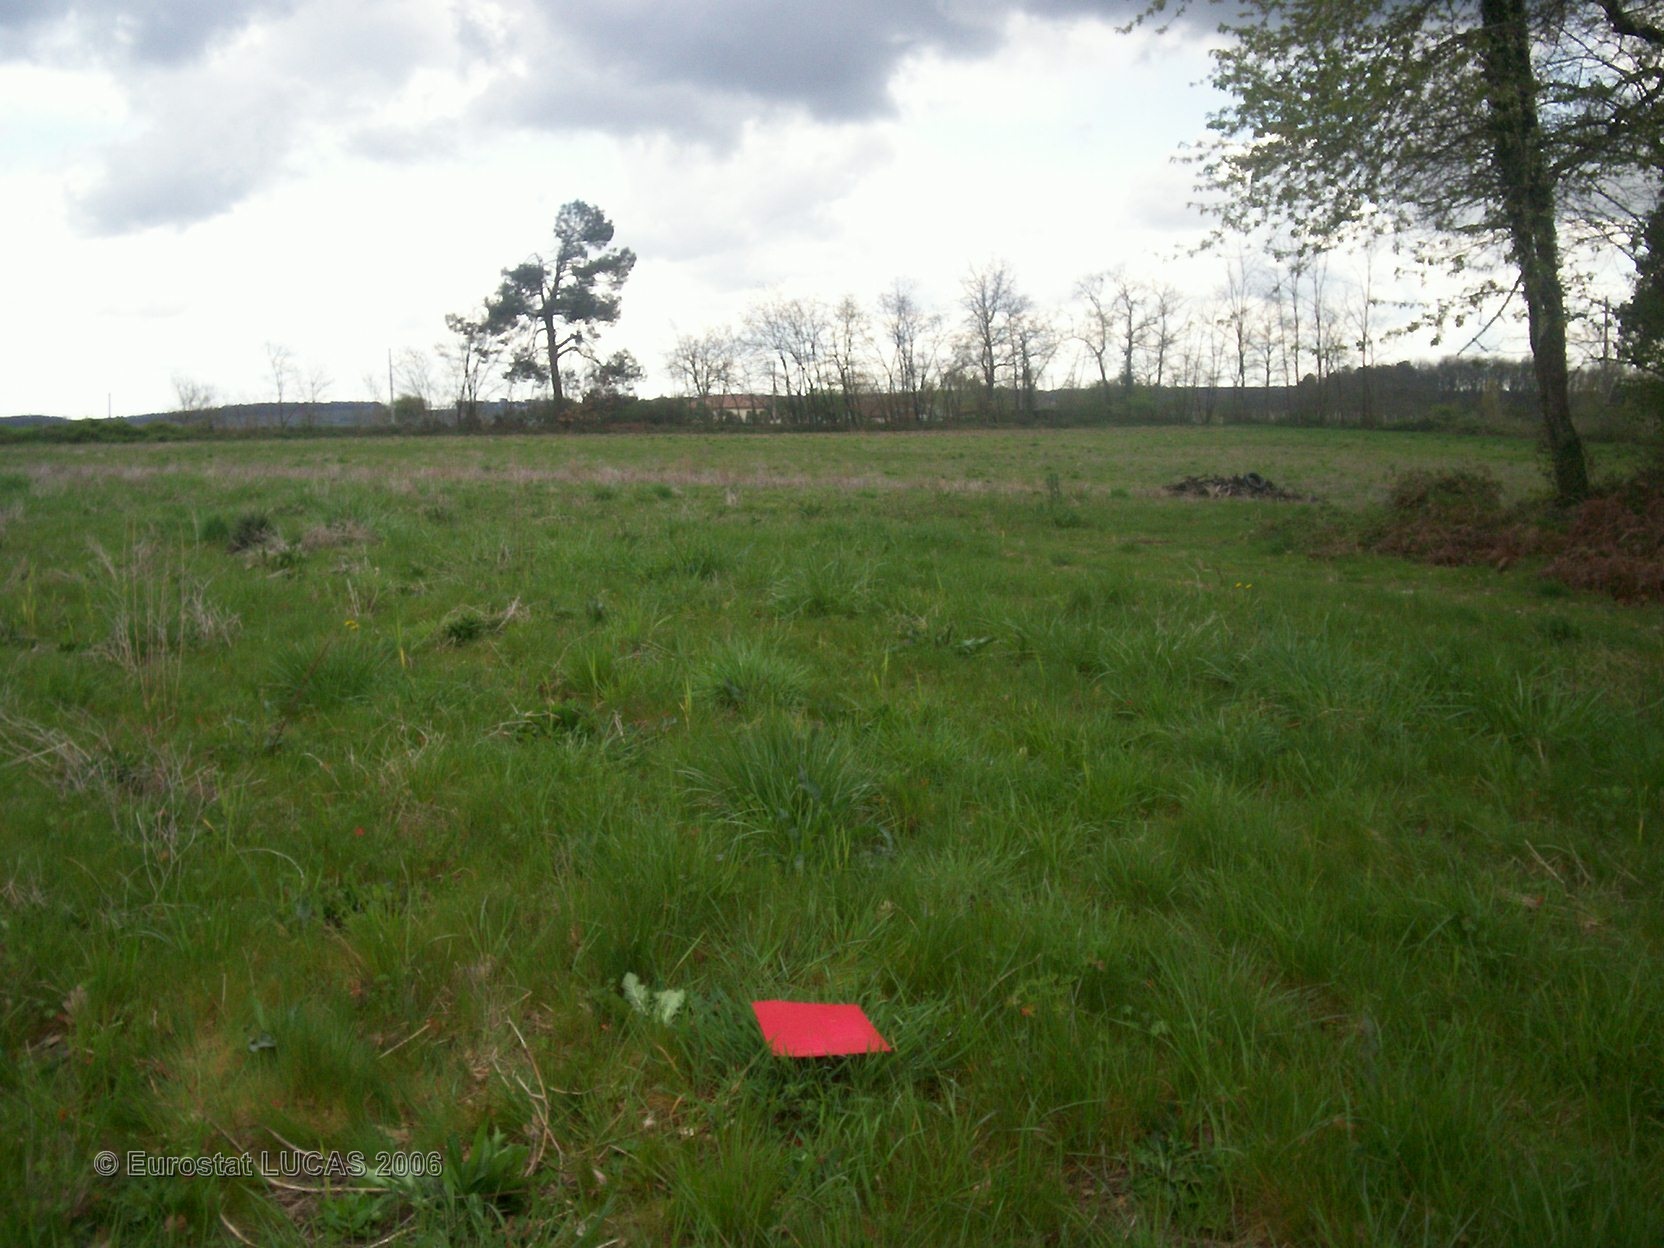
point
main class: Grassland
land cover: Grassland with sparse tree/shrub cover
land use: Agriculture (excluding fallow land and kitchen gardens)
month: April
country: FR
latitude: 43.9903
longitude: 0.1548
